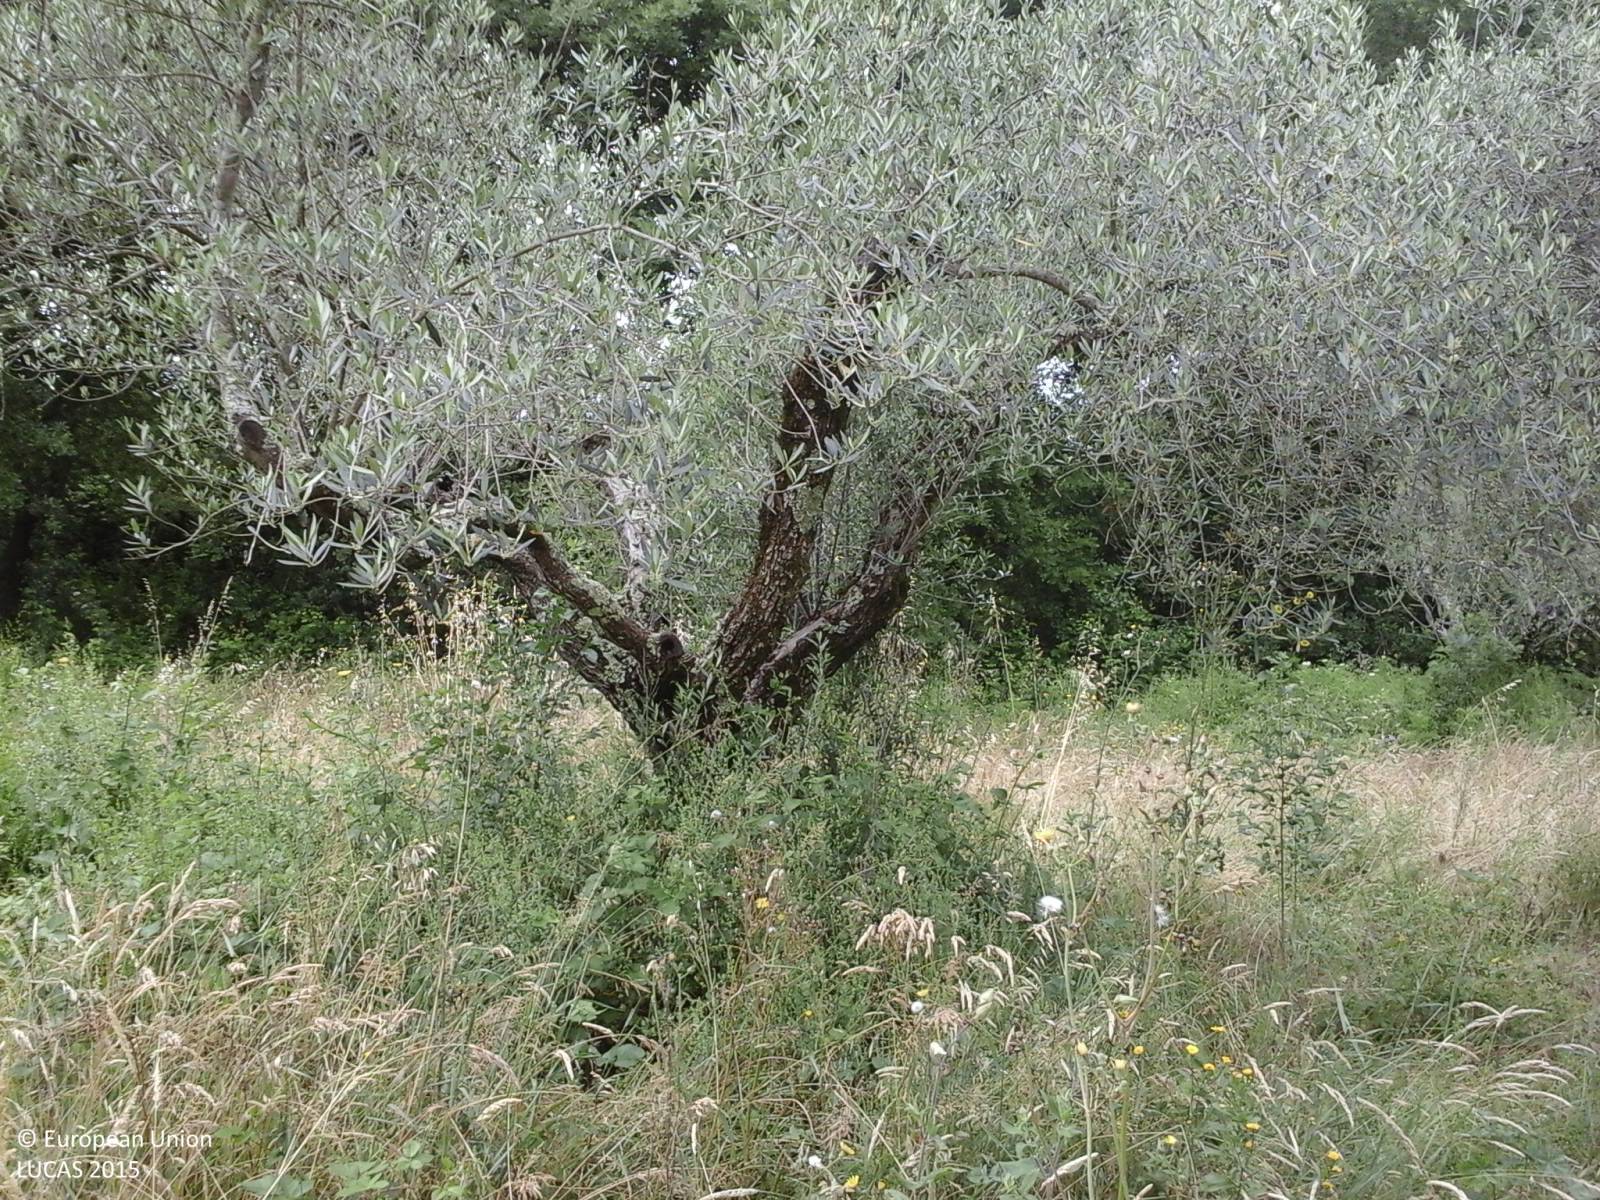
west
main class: Cropland
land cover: Olive groves
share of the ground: 50 - 75 %
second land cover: Grassland without tree/shrub cover
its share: > 75 %
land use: Agriculture (excluding fallow land and kitchen gardens)
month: May
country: IT
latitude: 42.2855
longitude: 12.2599
